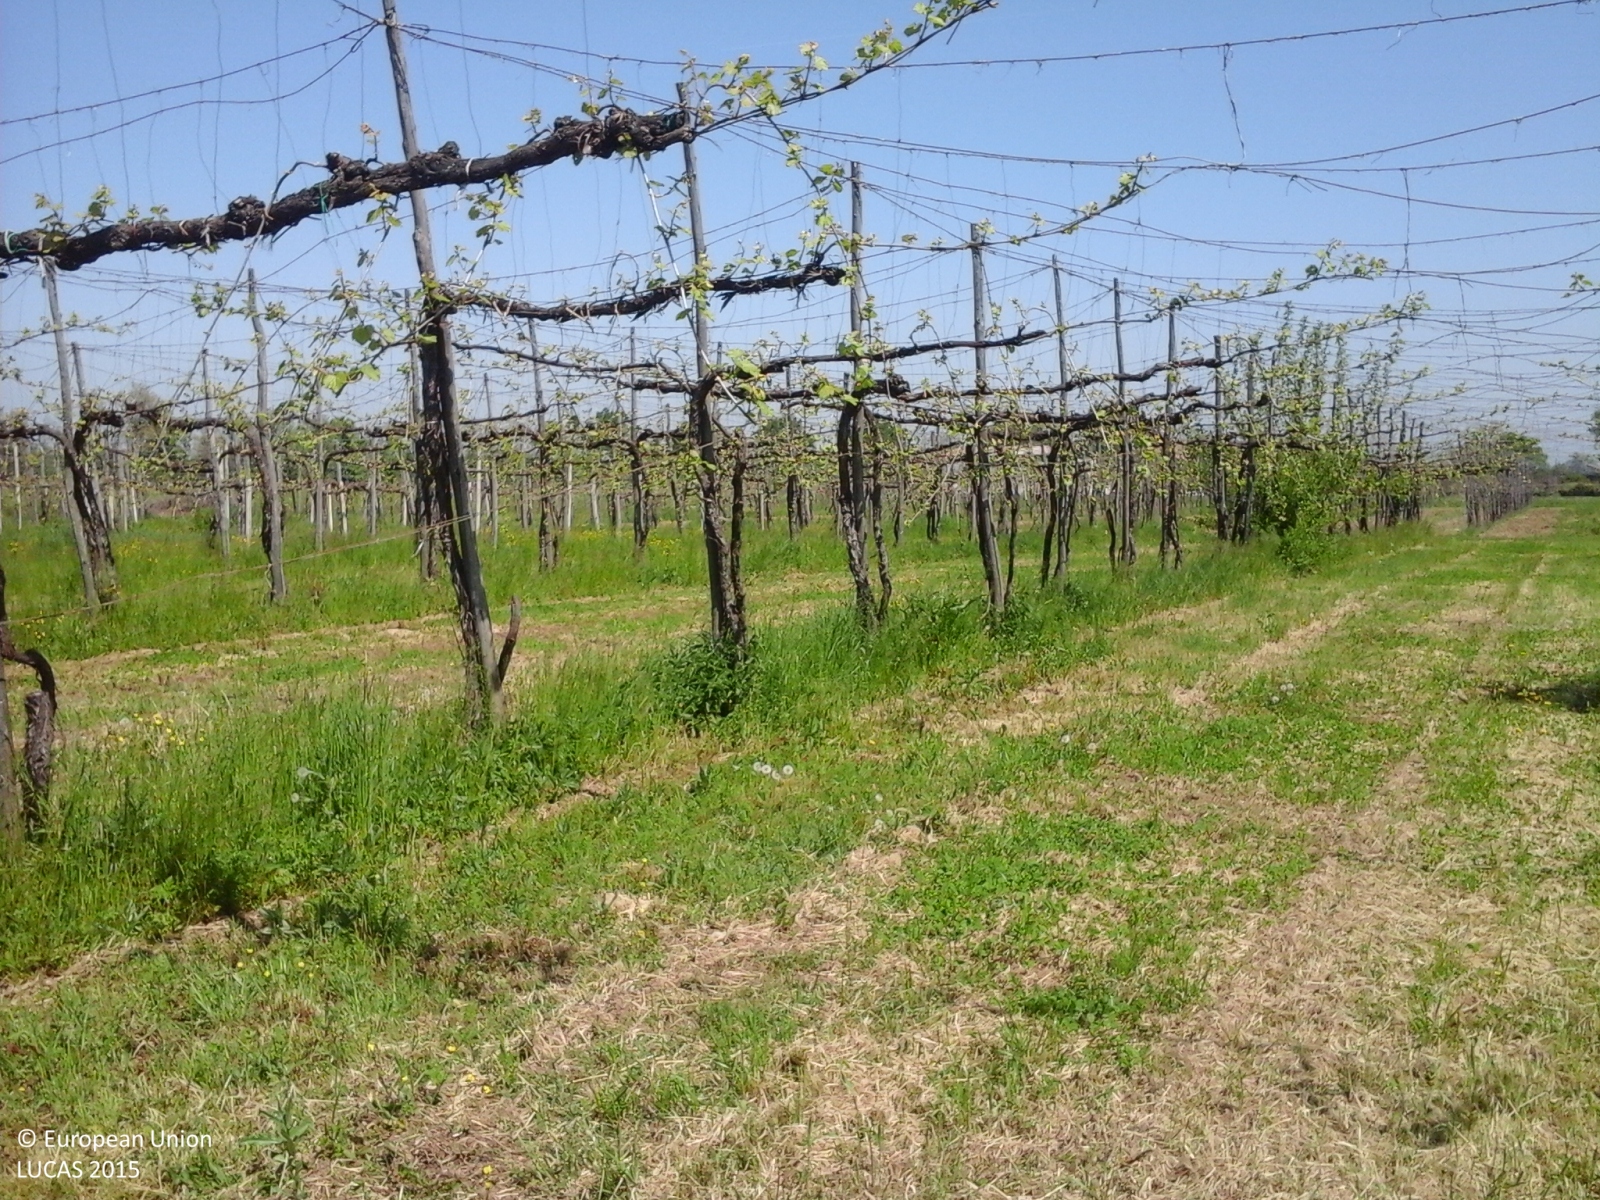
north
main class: Cropland
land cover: Vineyards
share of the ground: 10 - 25 %
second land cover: Spontaneously vegetated surfaces
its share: > 75 %
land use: Agriculture (excluding fallow land and kitchen gardens)
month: April
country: IT
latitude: 44.5812
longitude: 10.8923
